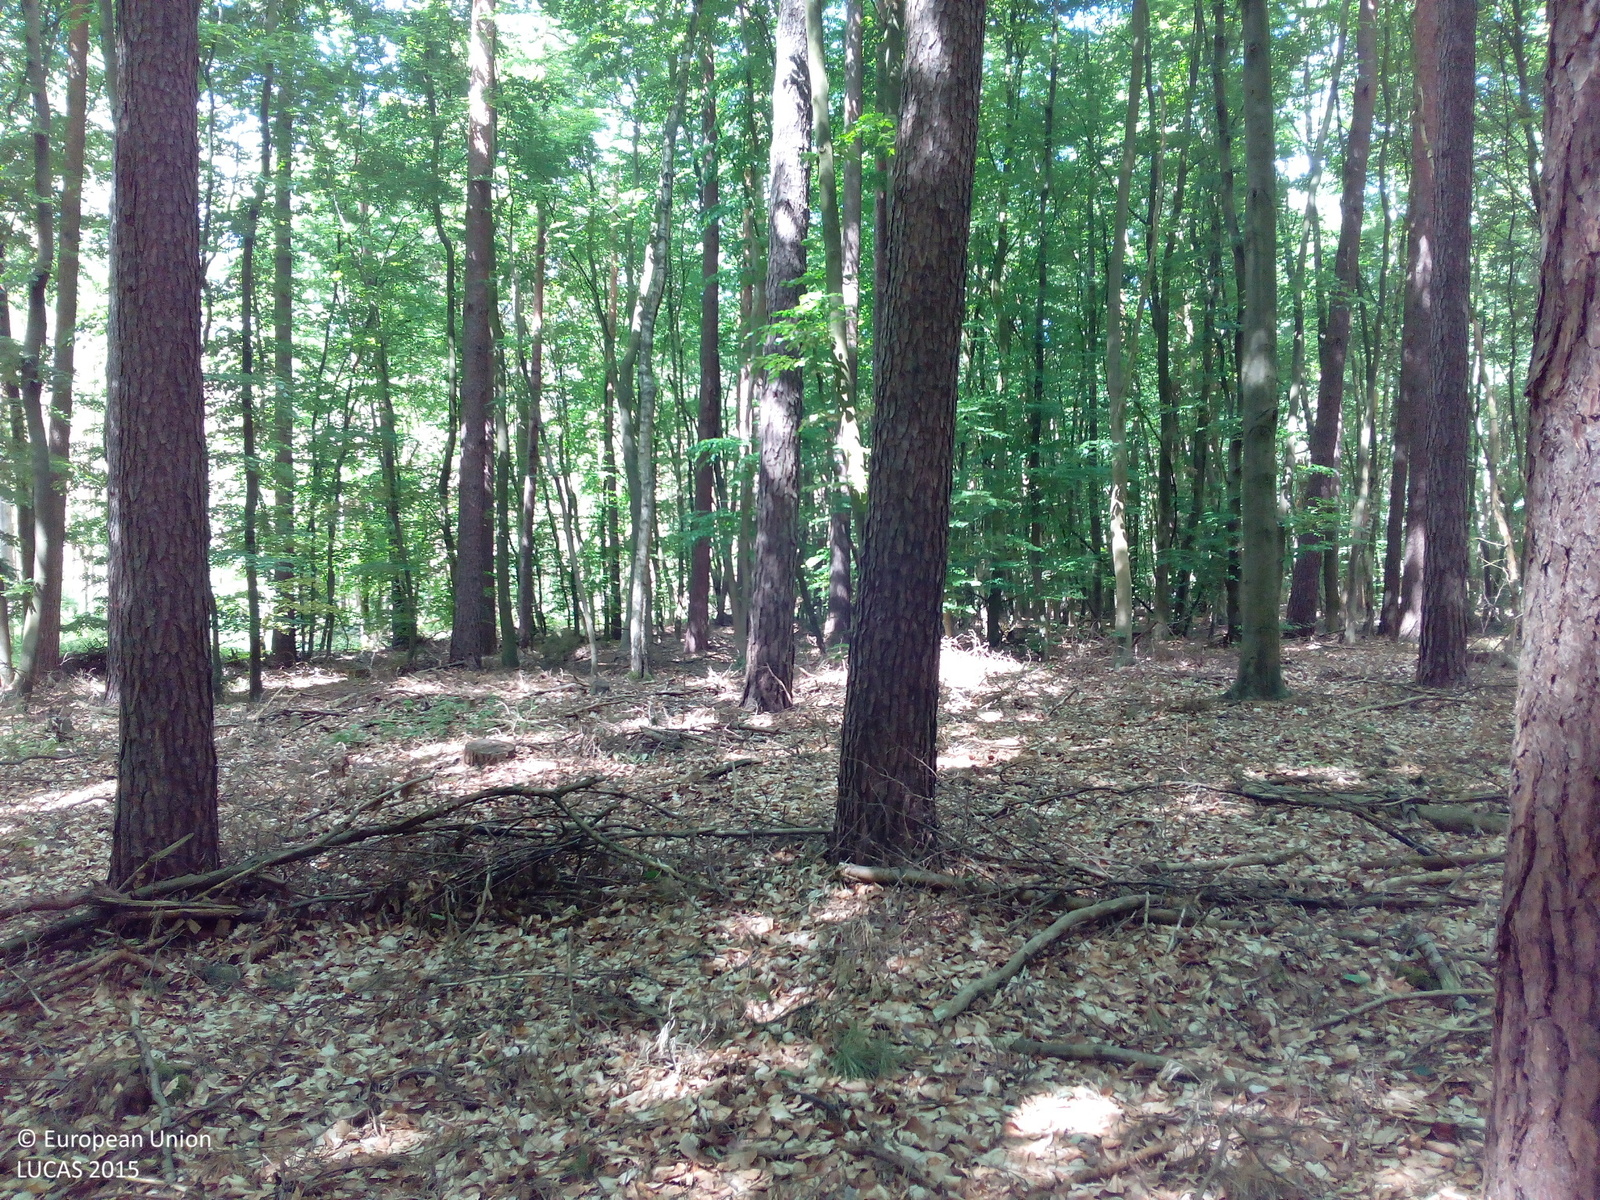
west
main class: Woodland
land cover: Pine dominated mixed woodland
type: hemiboreal forest and nemoral coniferous forest and mixed broadleaved-coniferous forest
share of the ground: > 75 %
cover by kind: coniferous forest trees 50 %, broadleaved forest trees 40 %, unconsolidated bare surface 10 %
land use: Forestry
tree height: > 5 m
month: June
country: DE
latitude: 53.5526
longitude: 11.6446
